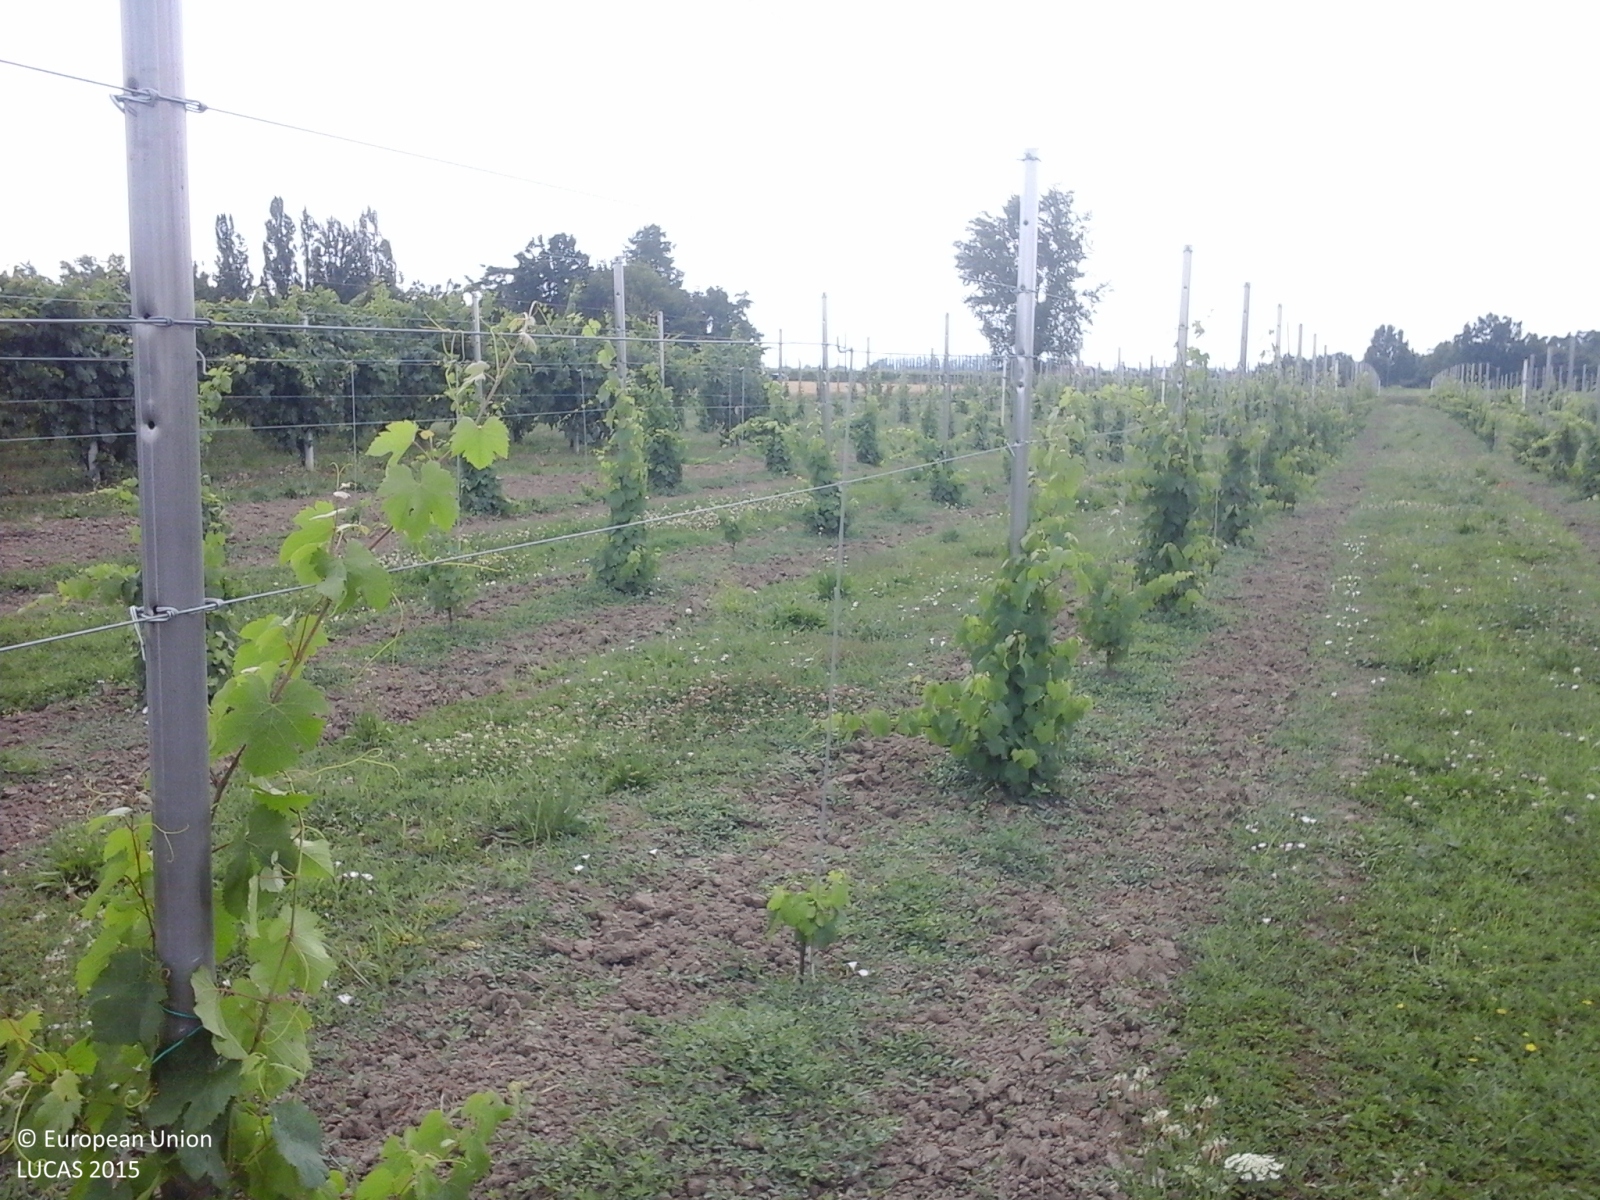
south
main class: Cropland
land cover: Vineyards
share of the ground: 25 - 50 %
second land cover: Grassland without tree/shrub cover
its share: > 75 %
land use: Agriculture (excluding fallow land and kitchen gardens)
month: June
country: IT
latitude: 44.7791
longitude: 10.9459
